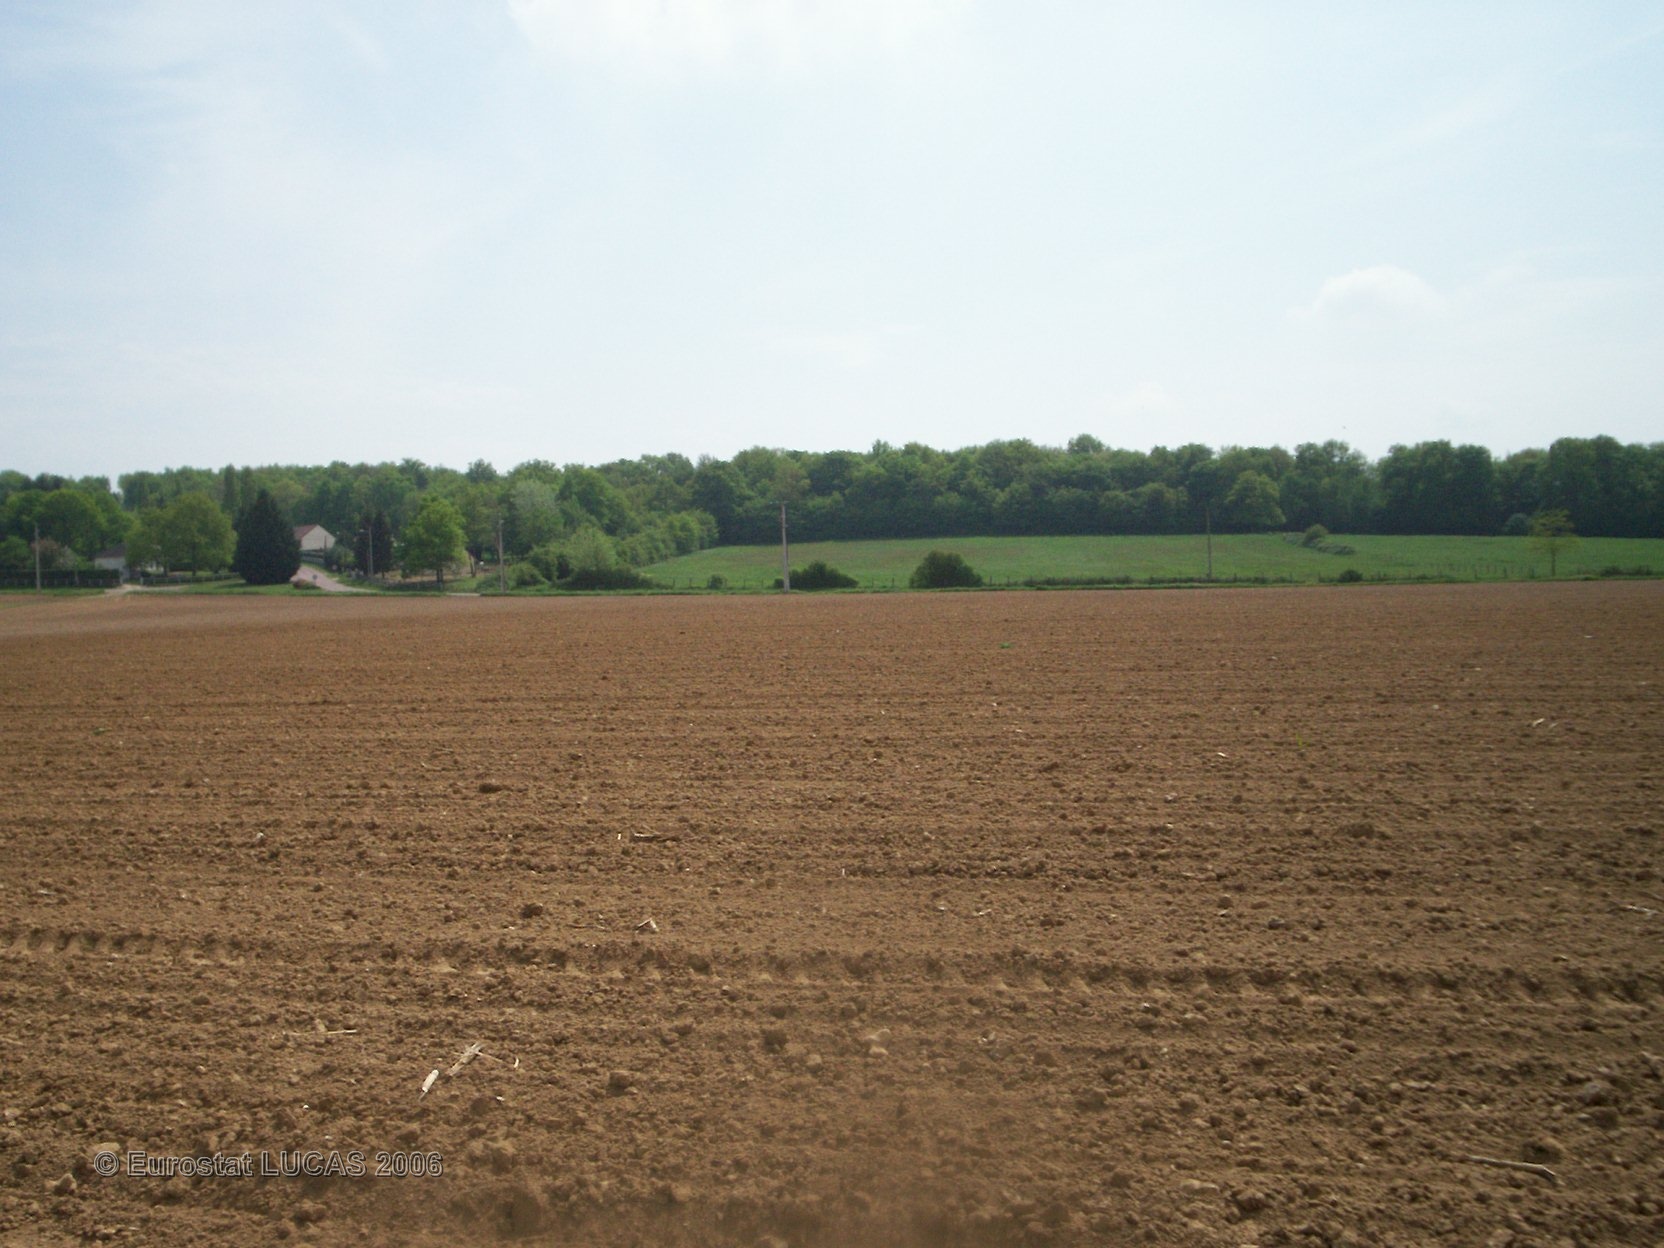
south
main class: Cropland
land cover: Maize
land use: Agriculture (excluding fallow land and kitchen gardens)
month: May
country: FR
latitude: 47.9248
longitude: 2.9399
